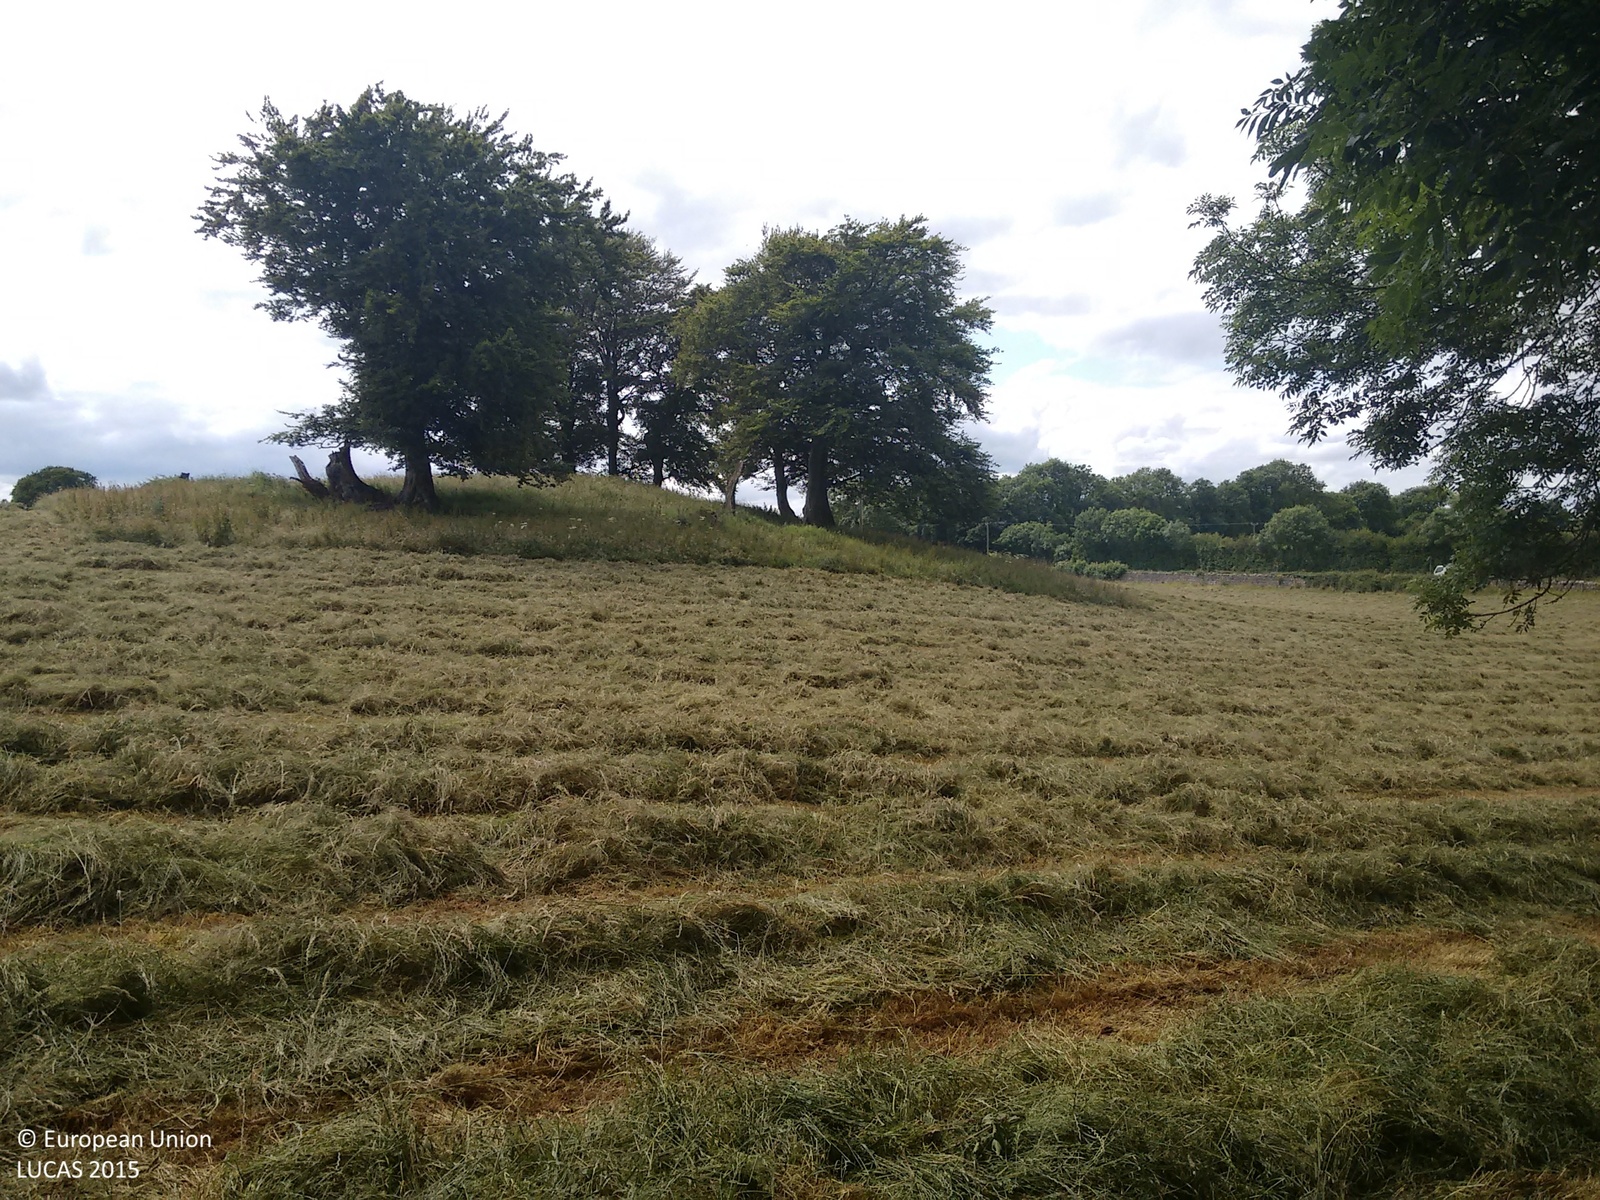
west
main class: Grassland
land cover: Grassland without tree/shrub cover
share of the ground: > 75 %
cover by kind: herbaceous plants 100 %
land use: Agriculture (excluding fallow land and kitchen gardens)
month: July
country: IE
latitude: 53.5458
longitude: -7.7794
